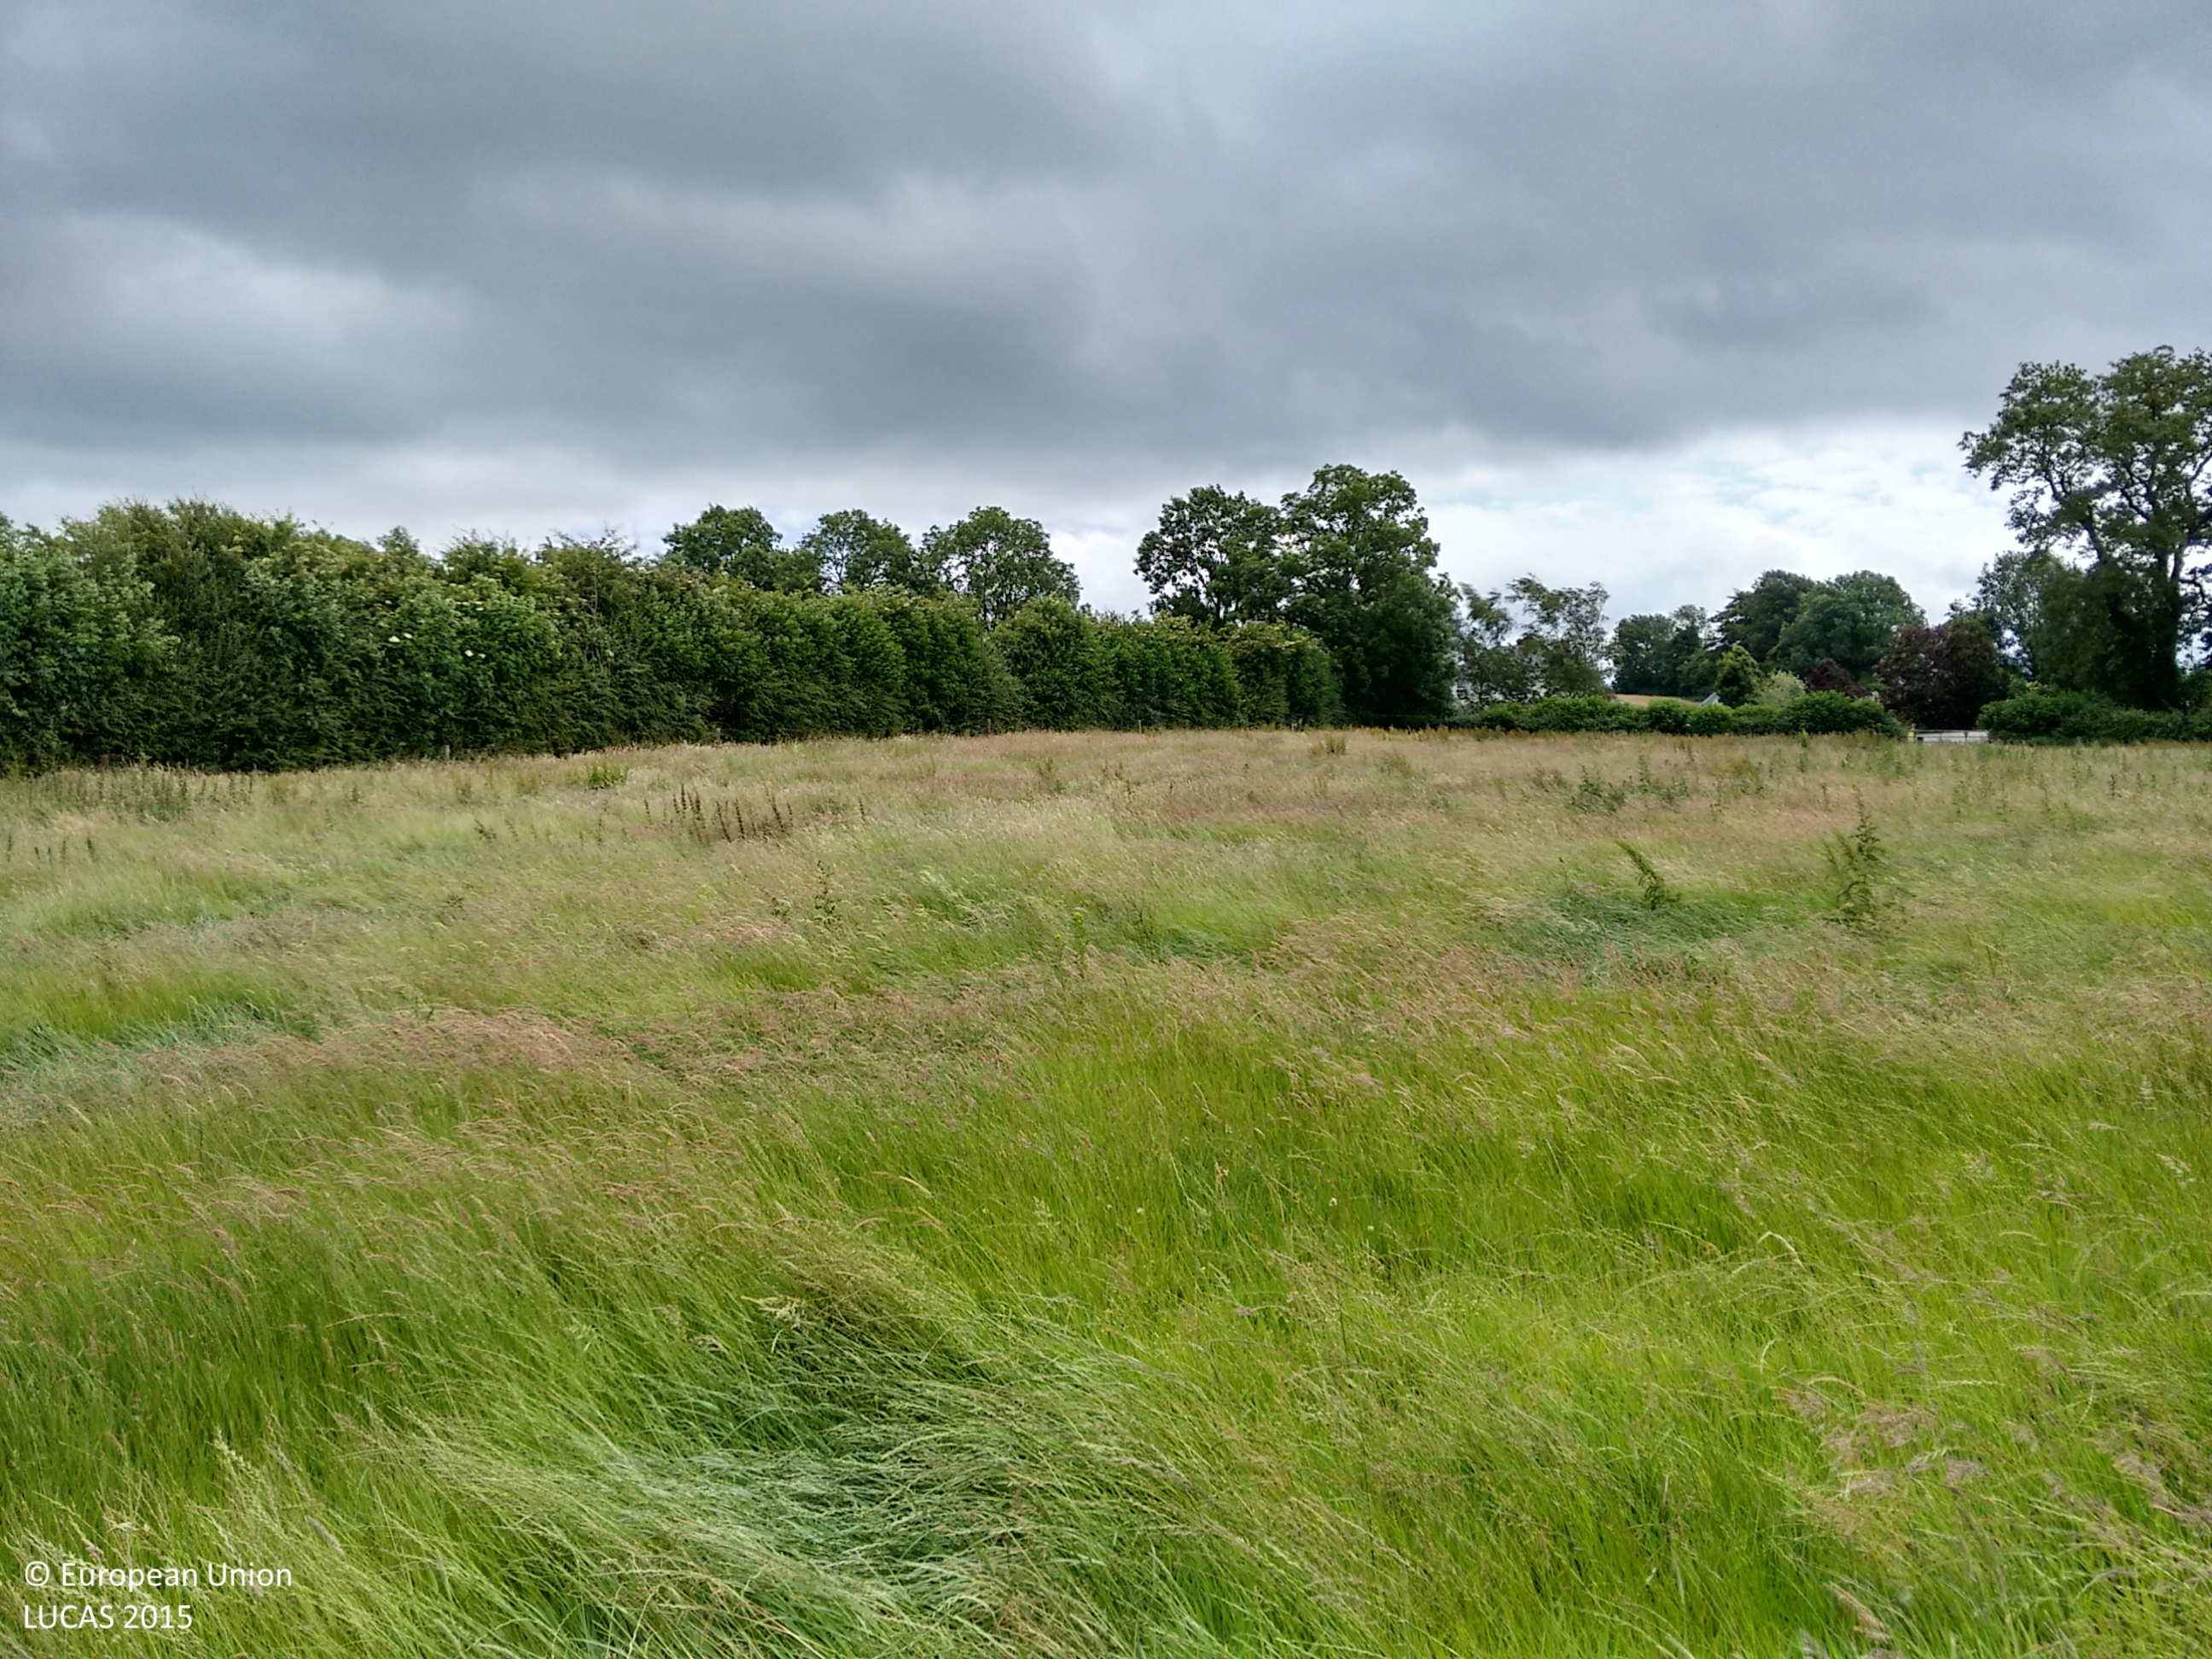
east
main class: Grassland
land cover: Grassland without tree/shrub cover
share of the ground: > 75 %
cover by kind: herbaceous plants 100 %
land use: Agriculture (excluding fallow land and kitchen gardens)
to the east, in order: Grassland without tree/shrub cover; Managed hedges; Artificial constructions in urban areas; Grassland without tree/shrub cover
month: July
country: IE
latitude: 52.9484
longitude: -6.8207
